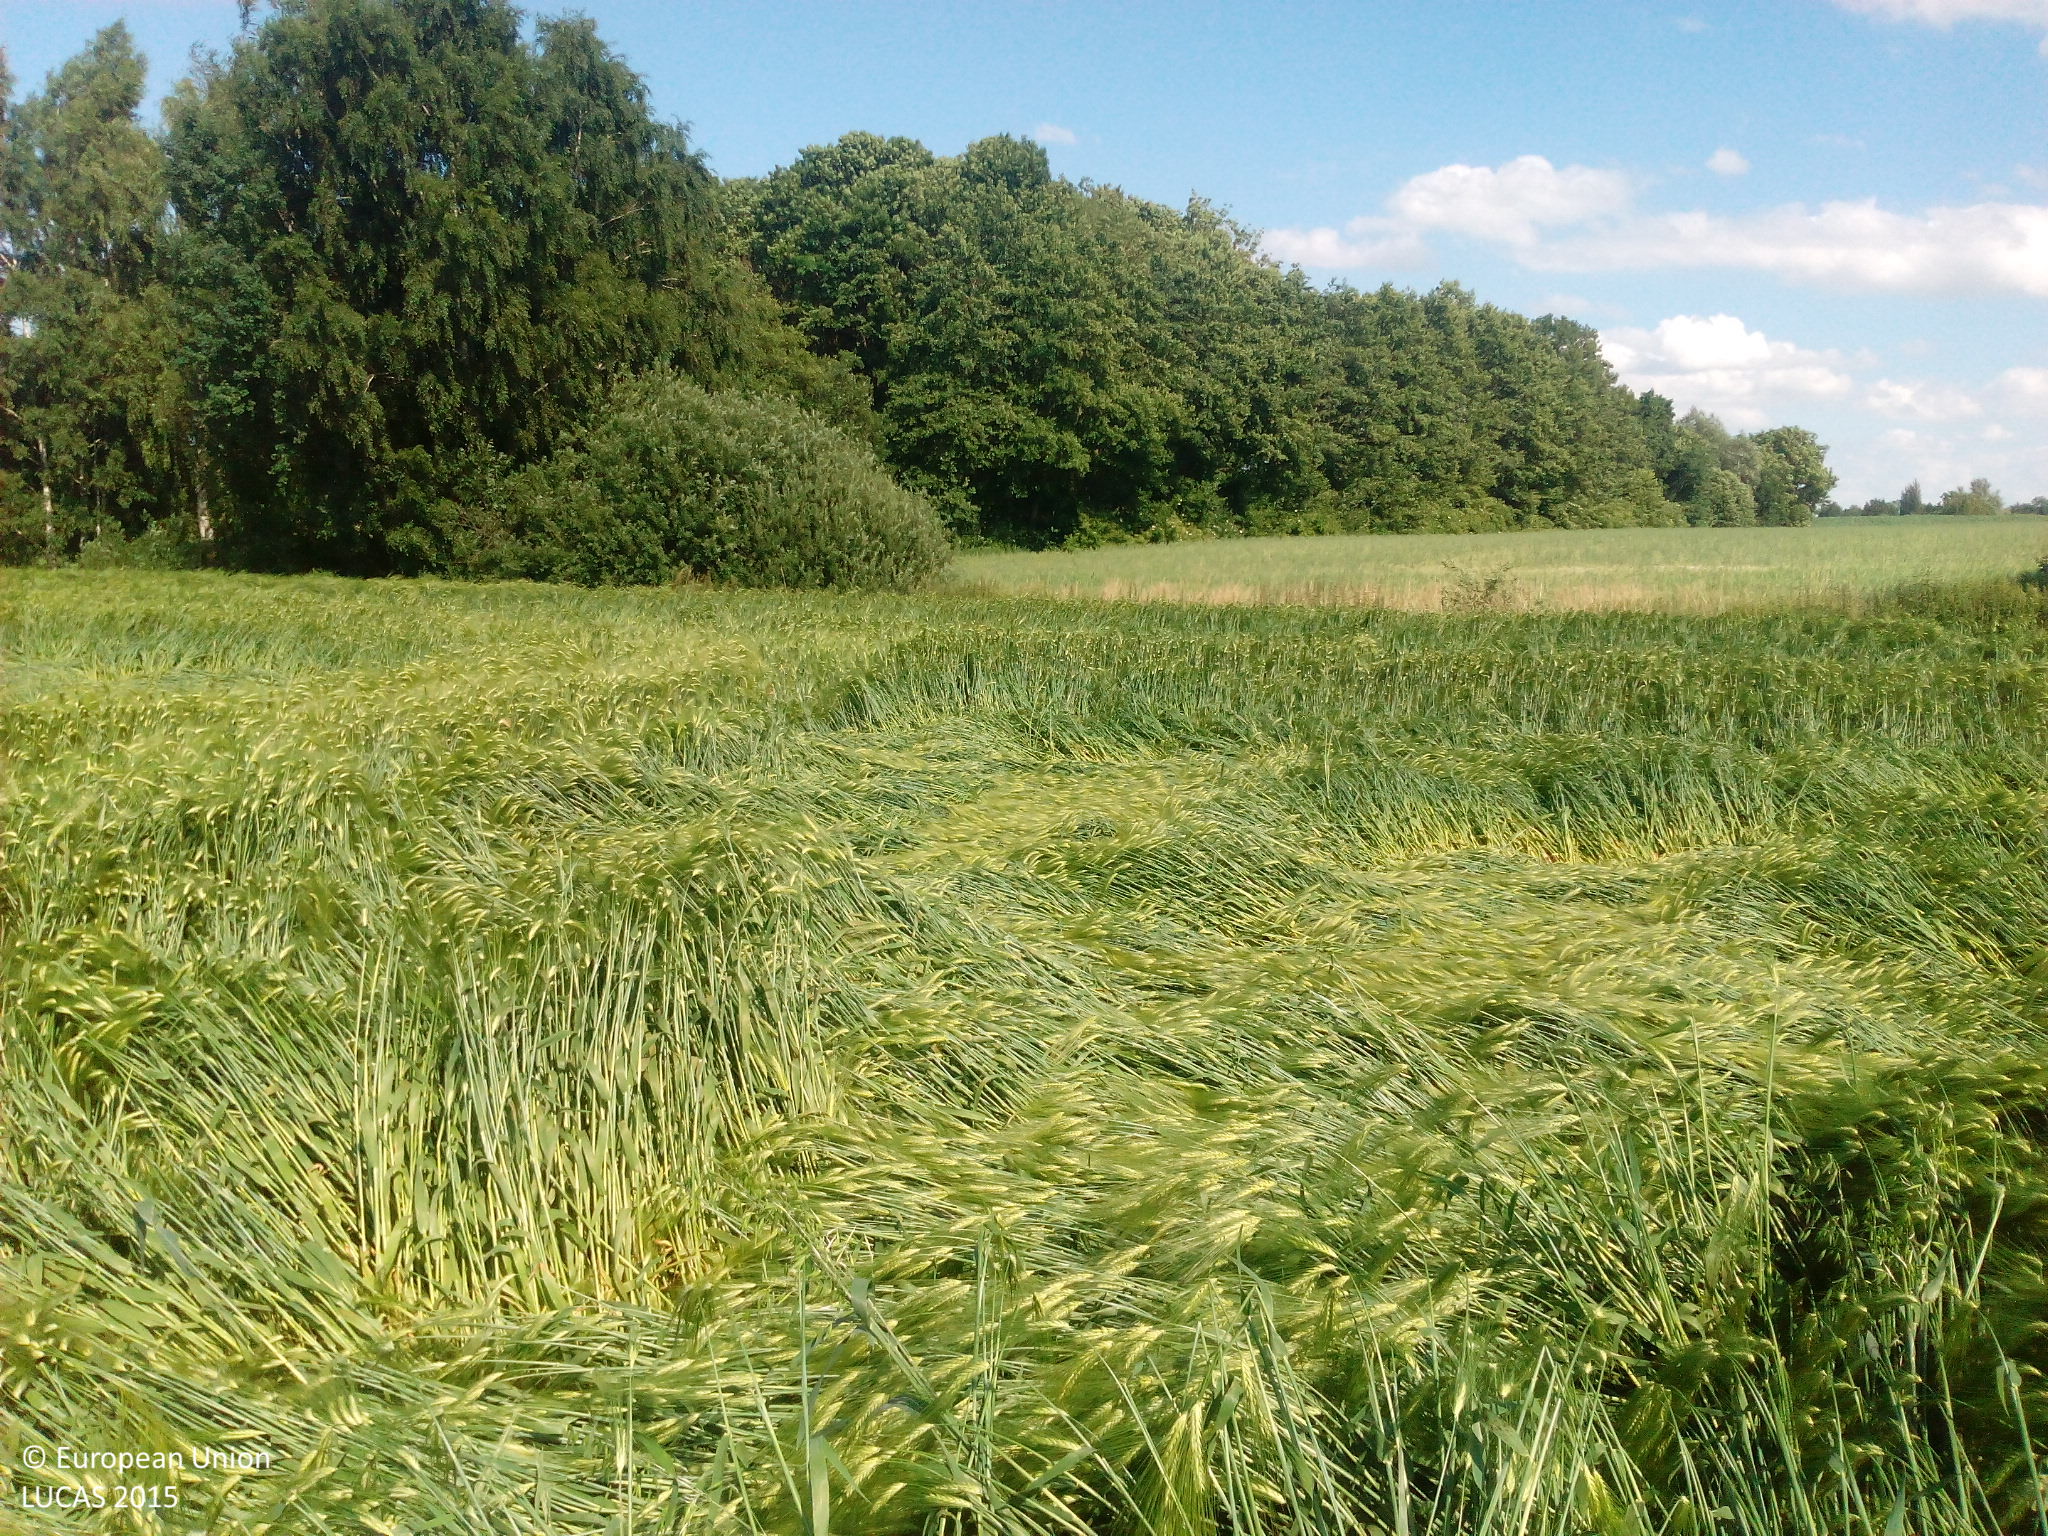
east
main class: Cropland
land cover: Barley
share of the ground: > 75 %
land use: Agriculture (excluding fallow land and kitchen gardens)
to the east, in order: Barley; Spontaneously vegetated surfaces; Ditches and canals; Spontaneously vegetated surfaces; Mixed cereals for fodder; Grass margins; Fences; Broadleaved woodland; Fences; Grass margins; Tracks; Maize
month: July
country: DE
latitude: 54.0778
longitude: 13.2548
